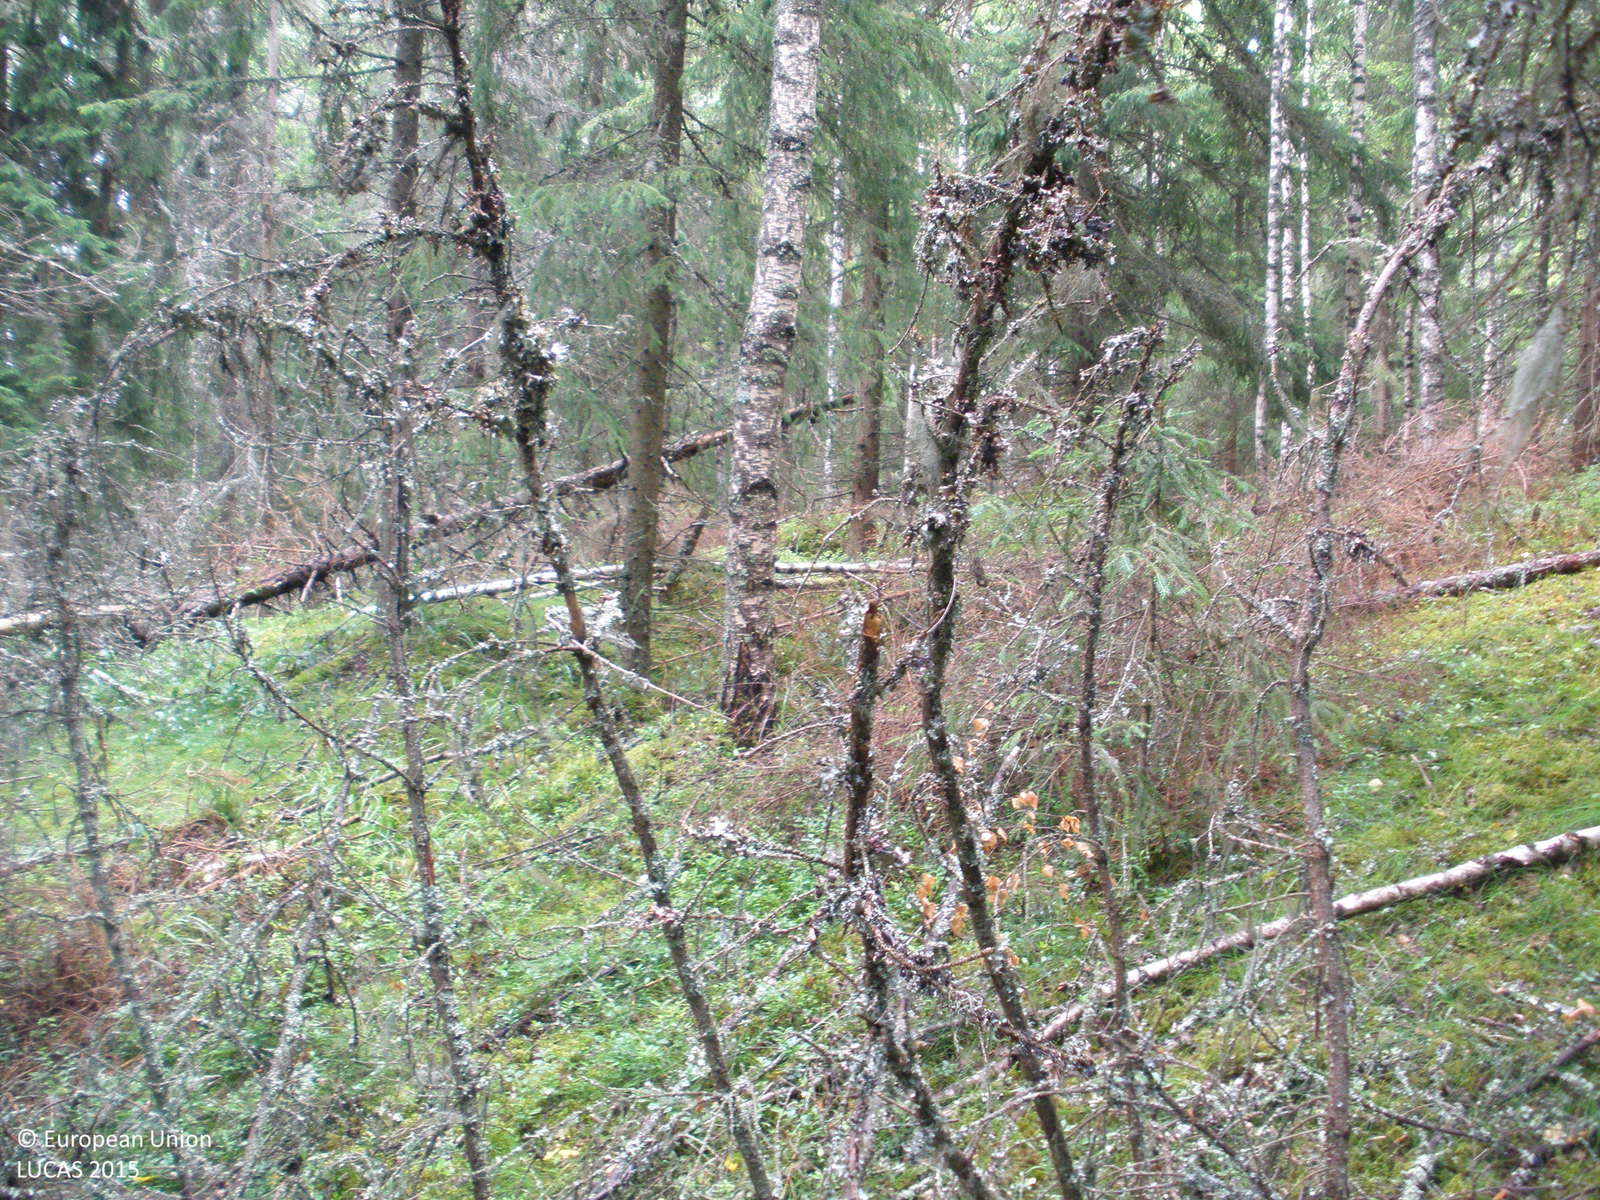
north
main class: Woodland
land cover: Spruce dominated mixed woodland
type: boreal forest
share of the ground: > 75 %
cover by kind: coniferous forest trees 60 %, broadleaved forest trees 30 %, herbaceous plants 5 %, lichens and mosses 5 %
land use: Forestry
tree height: > 5 m
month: July
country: FI
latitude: 61.4257
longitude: 23.1751
